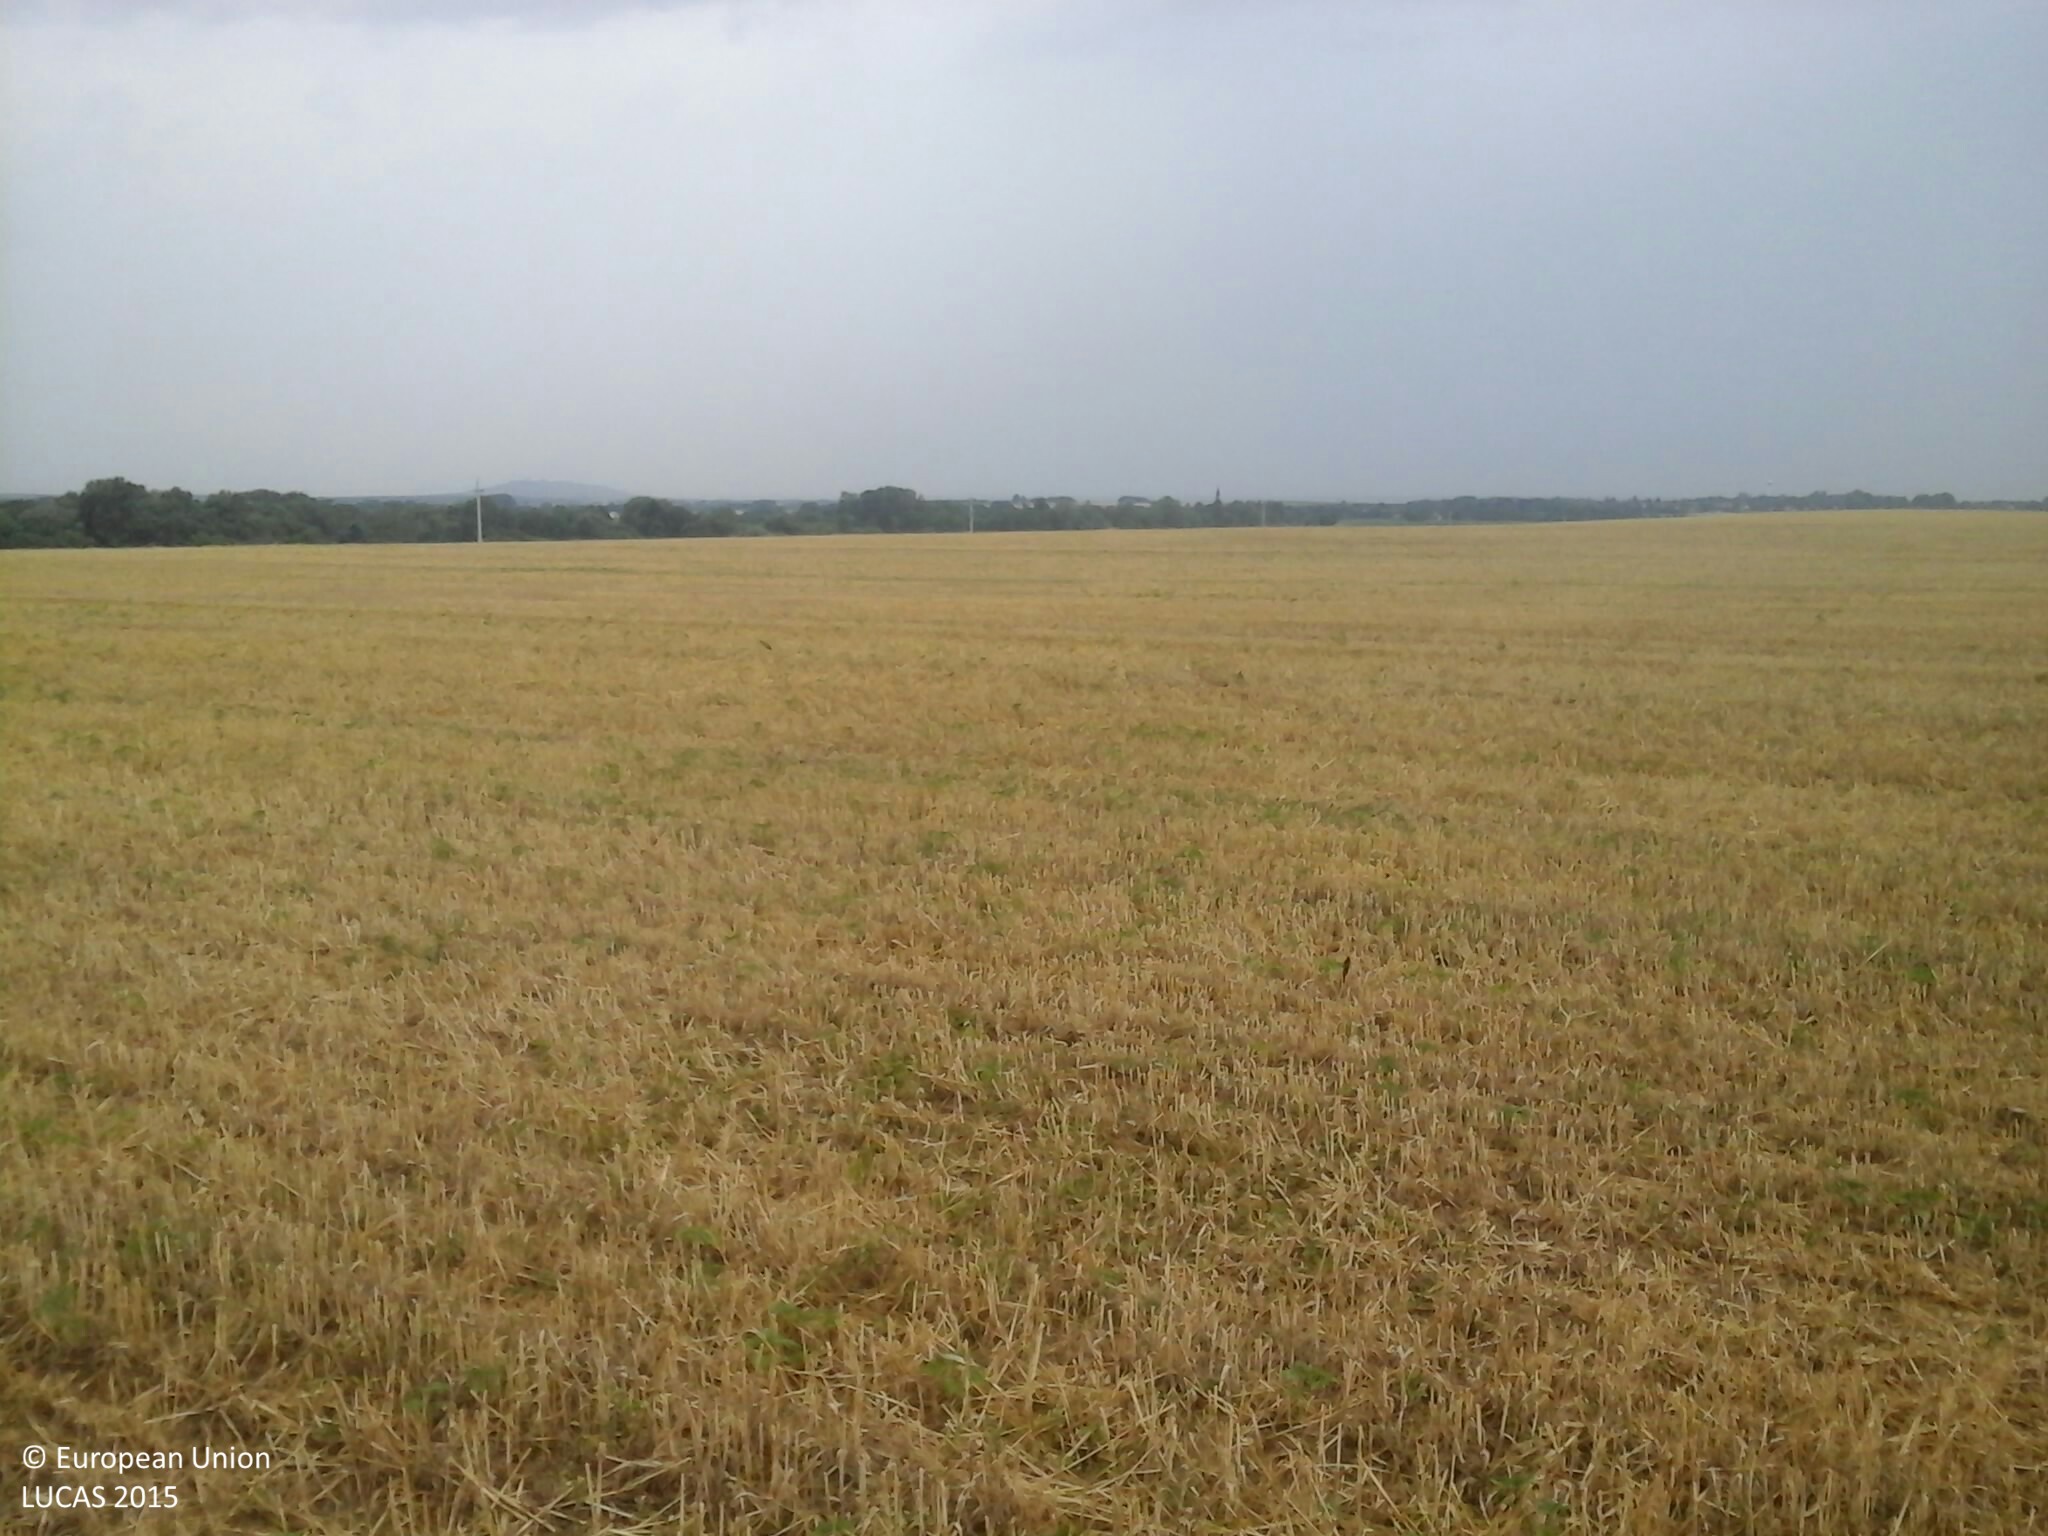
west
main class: Cropland
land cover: Common wheat
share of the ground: > 75 %
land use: Agriculture (excluding fallow land and kitchen gardens)
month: July
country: HU
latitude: 47.2057
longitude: 17.2803
